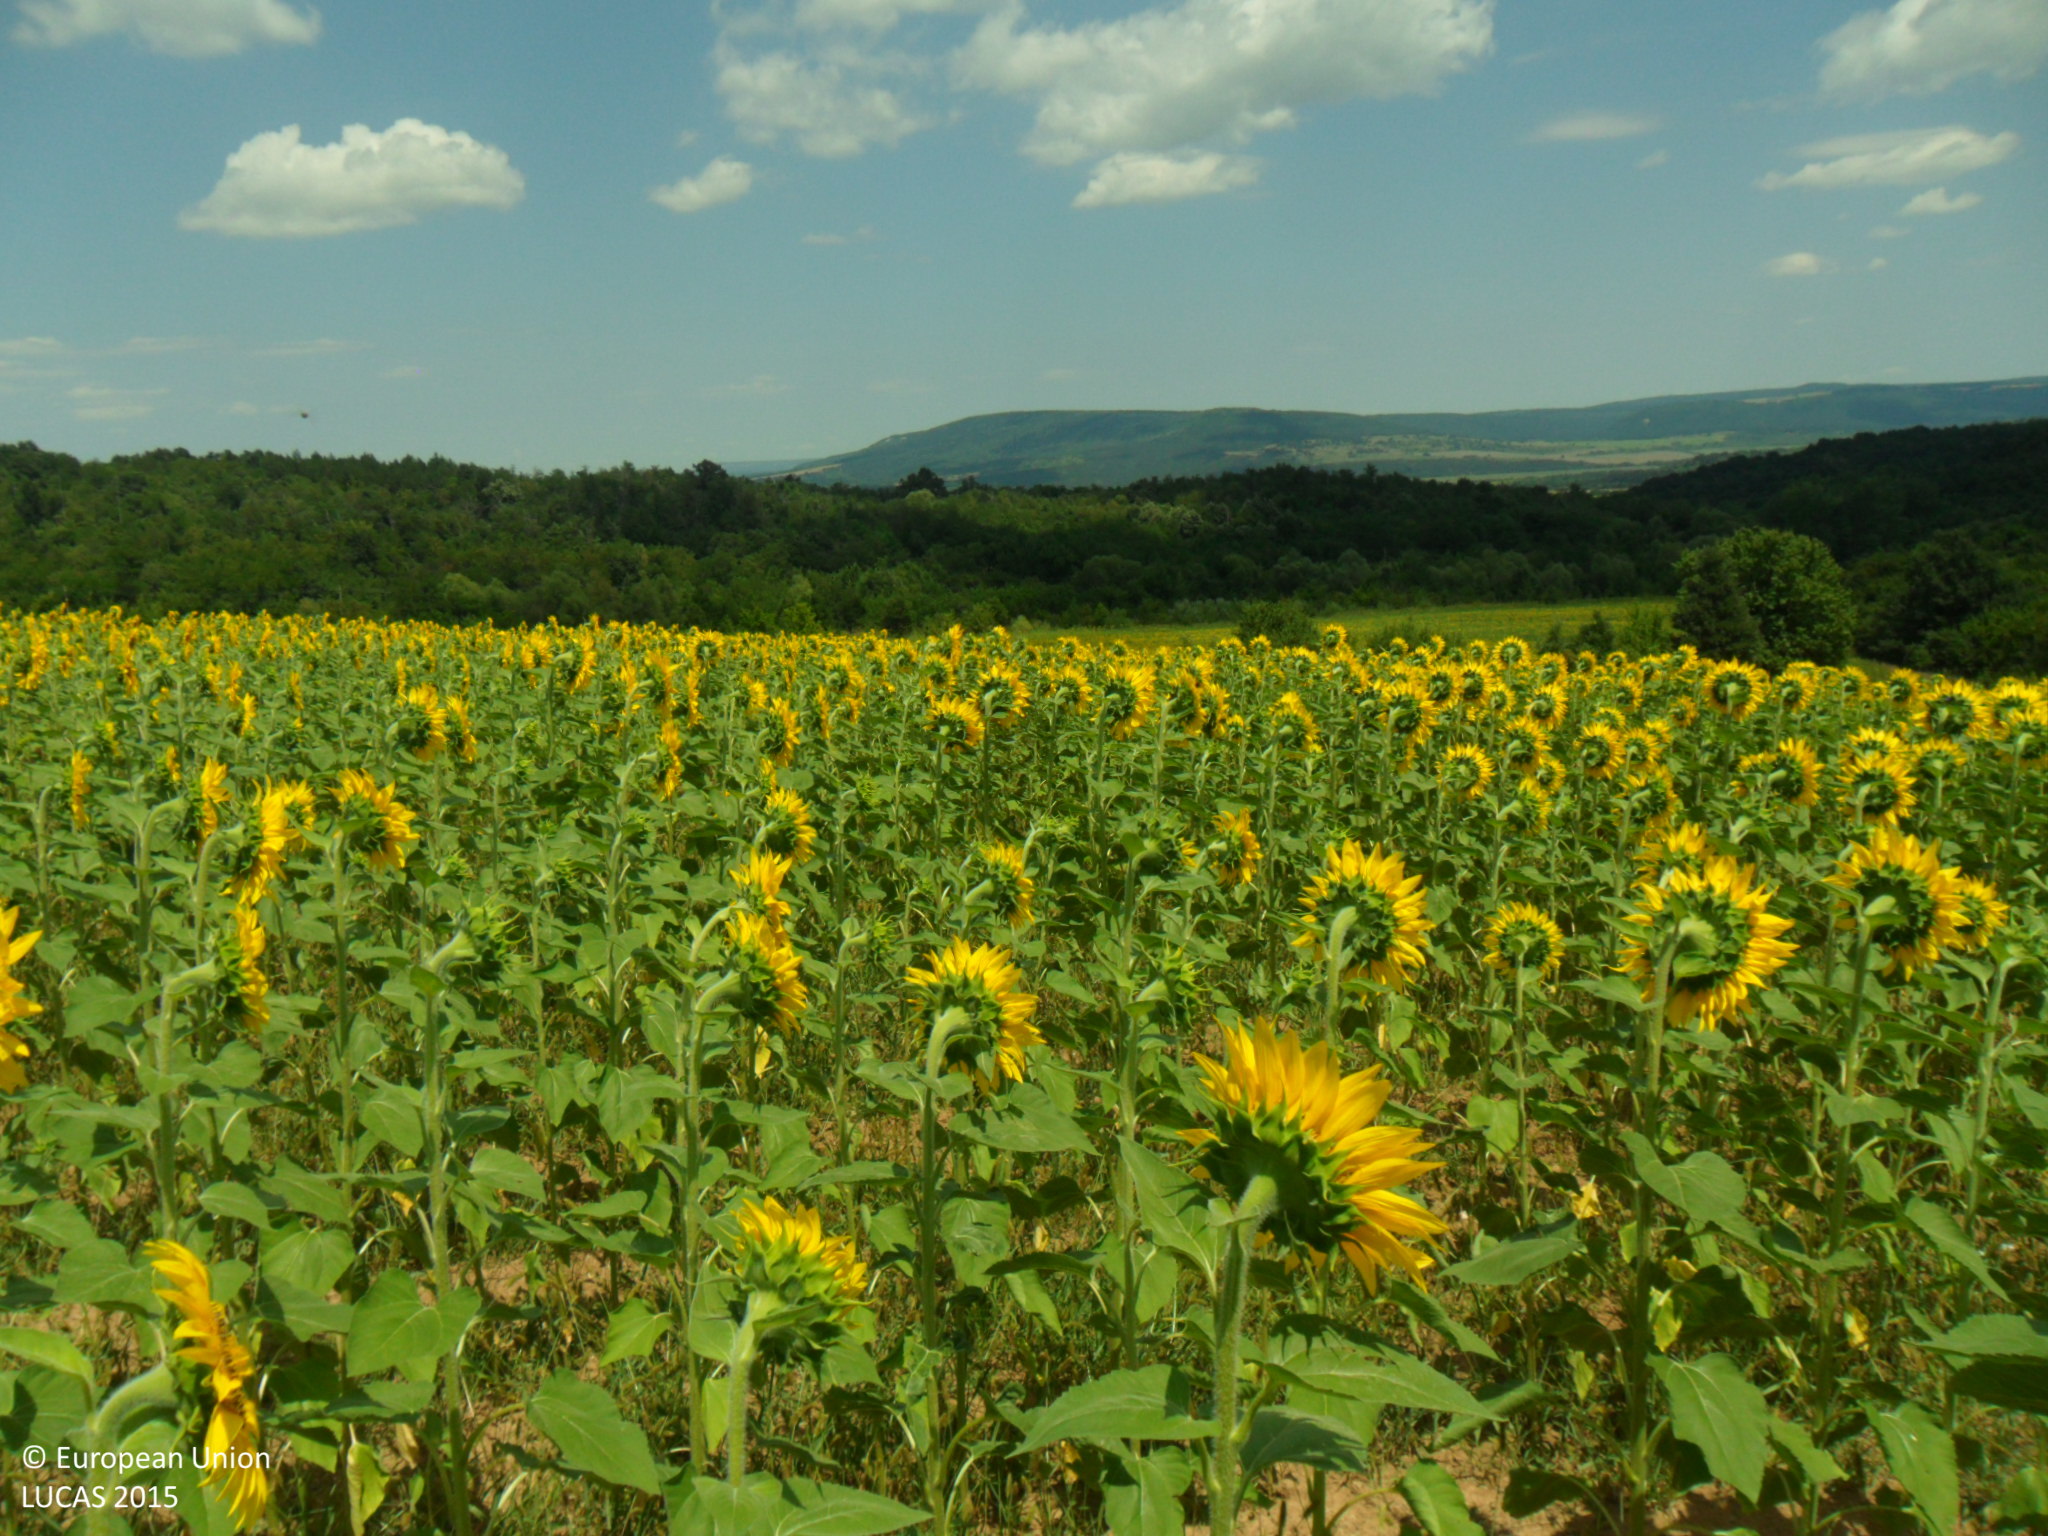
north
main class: Cropland
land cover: Sunflower
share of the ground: > 75 %
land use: Agriculture (excluding fallow land and kitchen gardens)
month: July
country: BG
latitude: 43.0431
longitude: 27.0152
